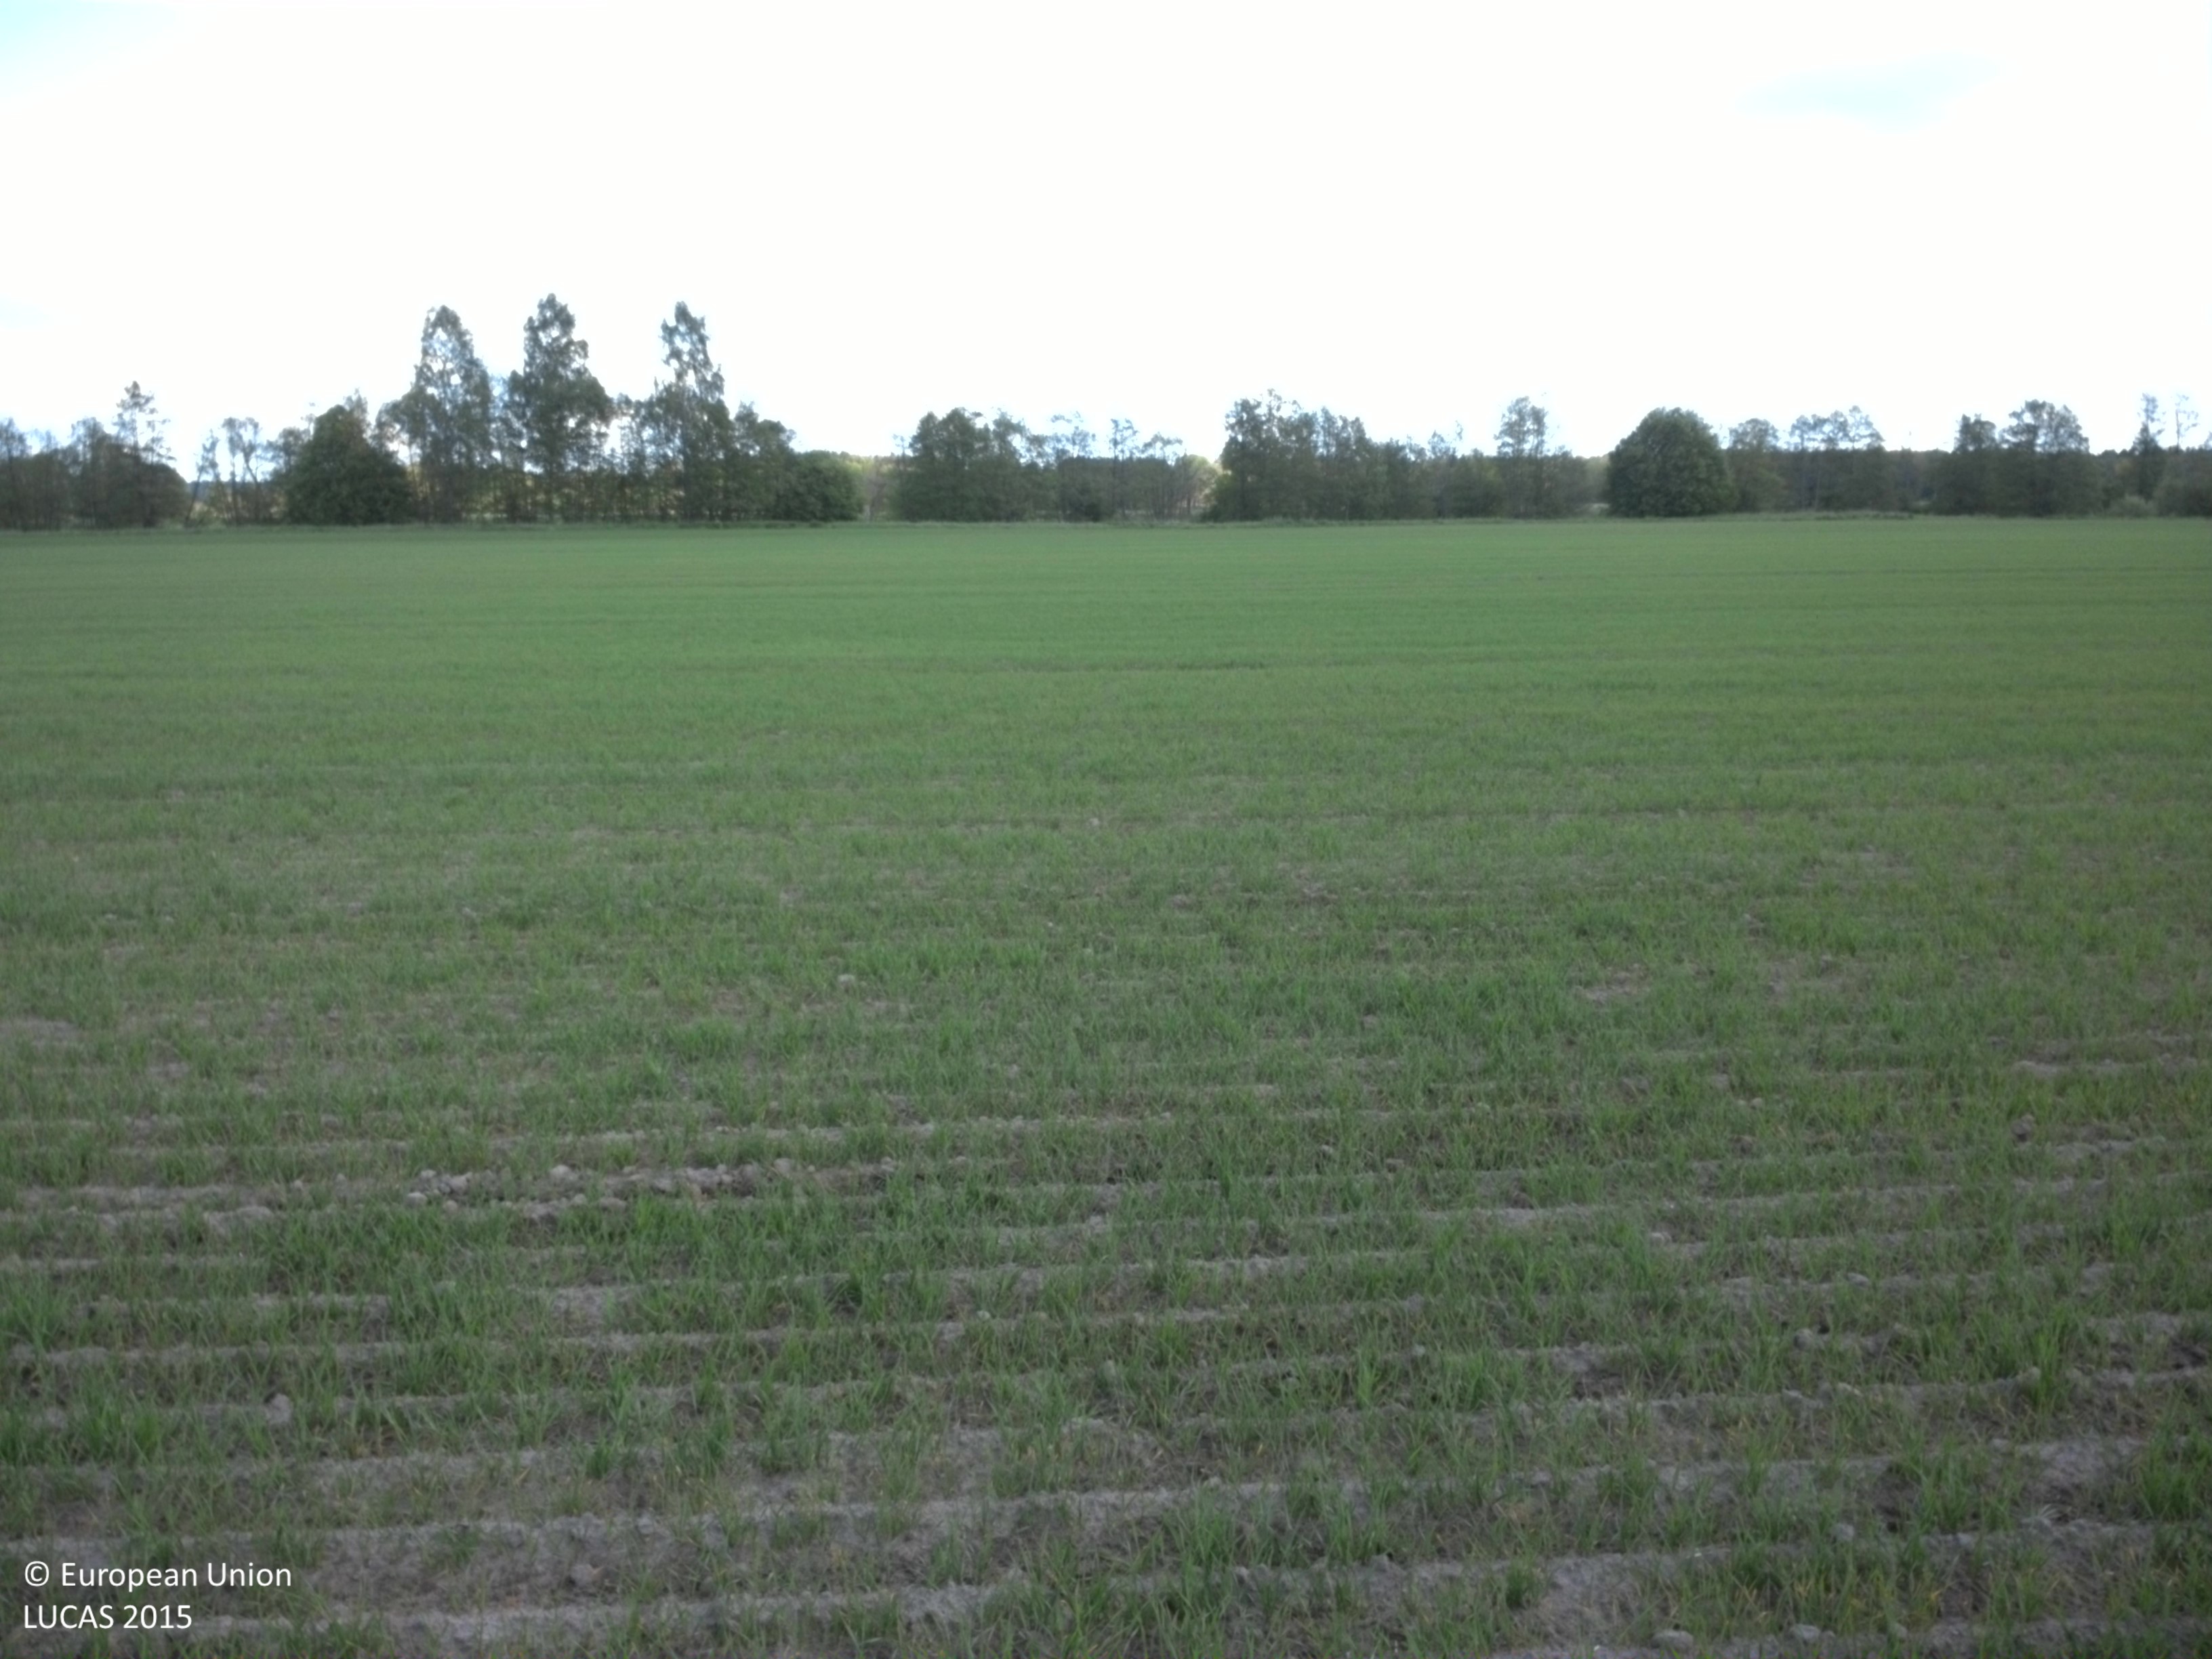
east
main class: Cropland
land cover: Common wheat
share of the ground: 50 - 75 %
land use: Agriculture (excluding fallow land and kitchen gardens)
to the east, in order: Common wheat; Grassland without tree/shrub cover; Broadleaved woodland; Inland fresh running water; Broadleaved woodland; Grassland without tree/shrub cover; Permanent crops (only in case pi)
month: May
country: SE
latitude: 57.3356
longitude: 15.8288
